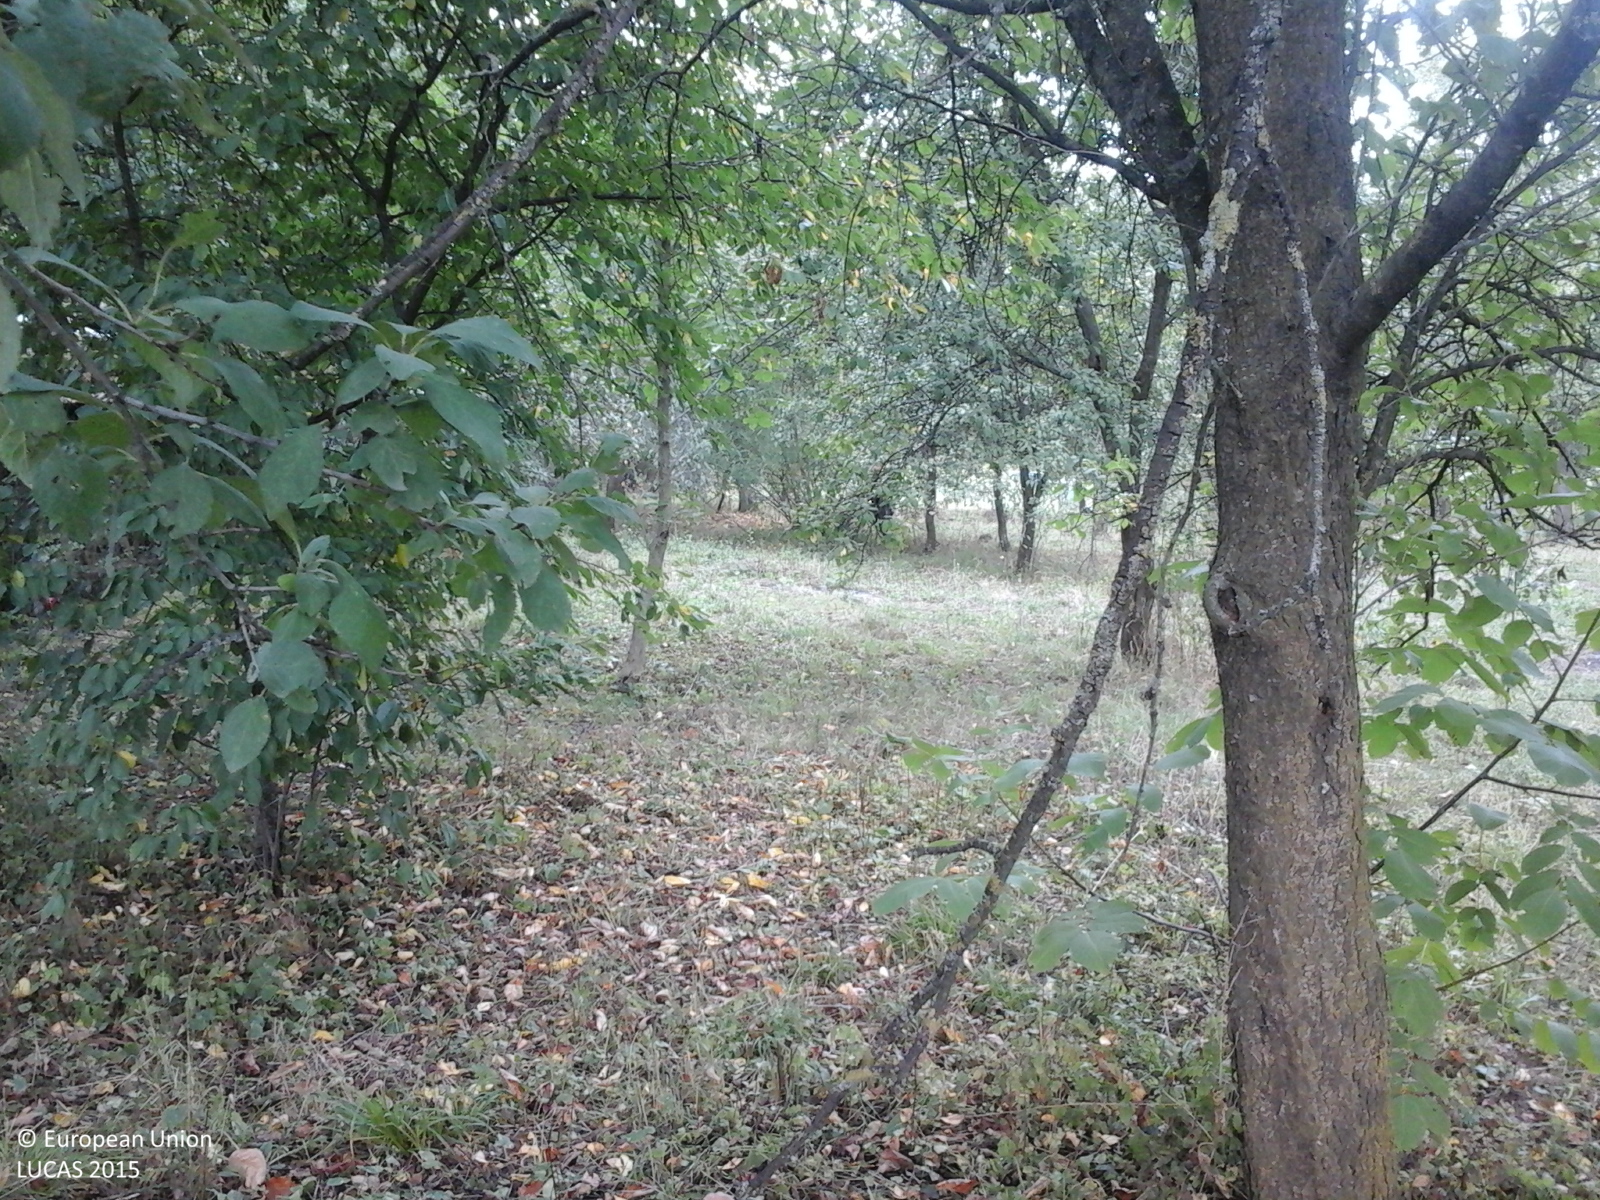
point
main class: Cropland
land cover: Apple fruit
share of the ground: 50 - 75 %
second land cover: Grassland without tree/shrub cover
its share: > 75 %
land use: Agriculture (excluding fallow land and kitchen gardens)
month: September
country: RO
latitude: 47.2930
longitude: 23.0905
